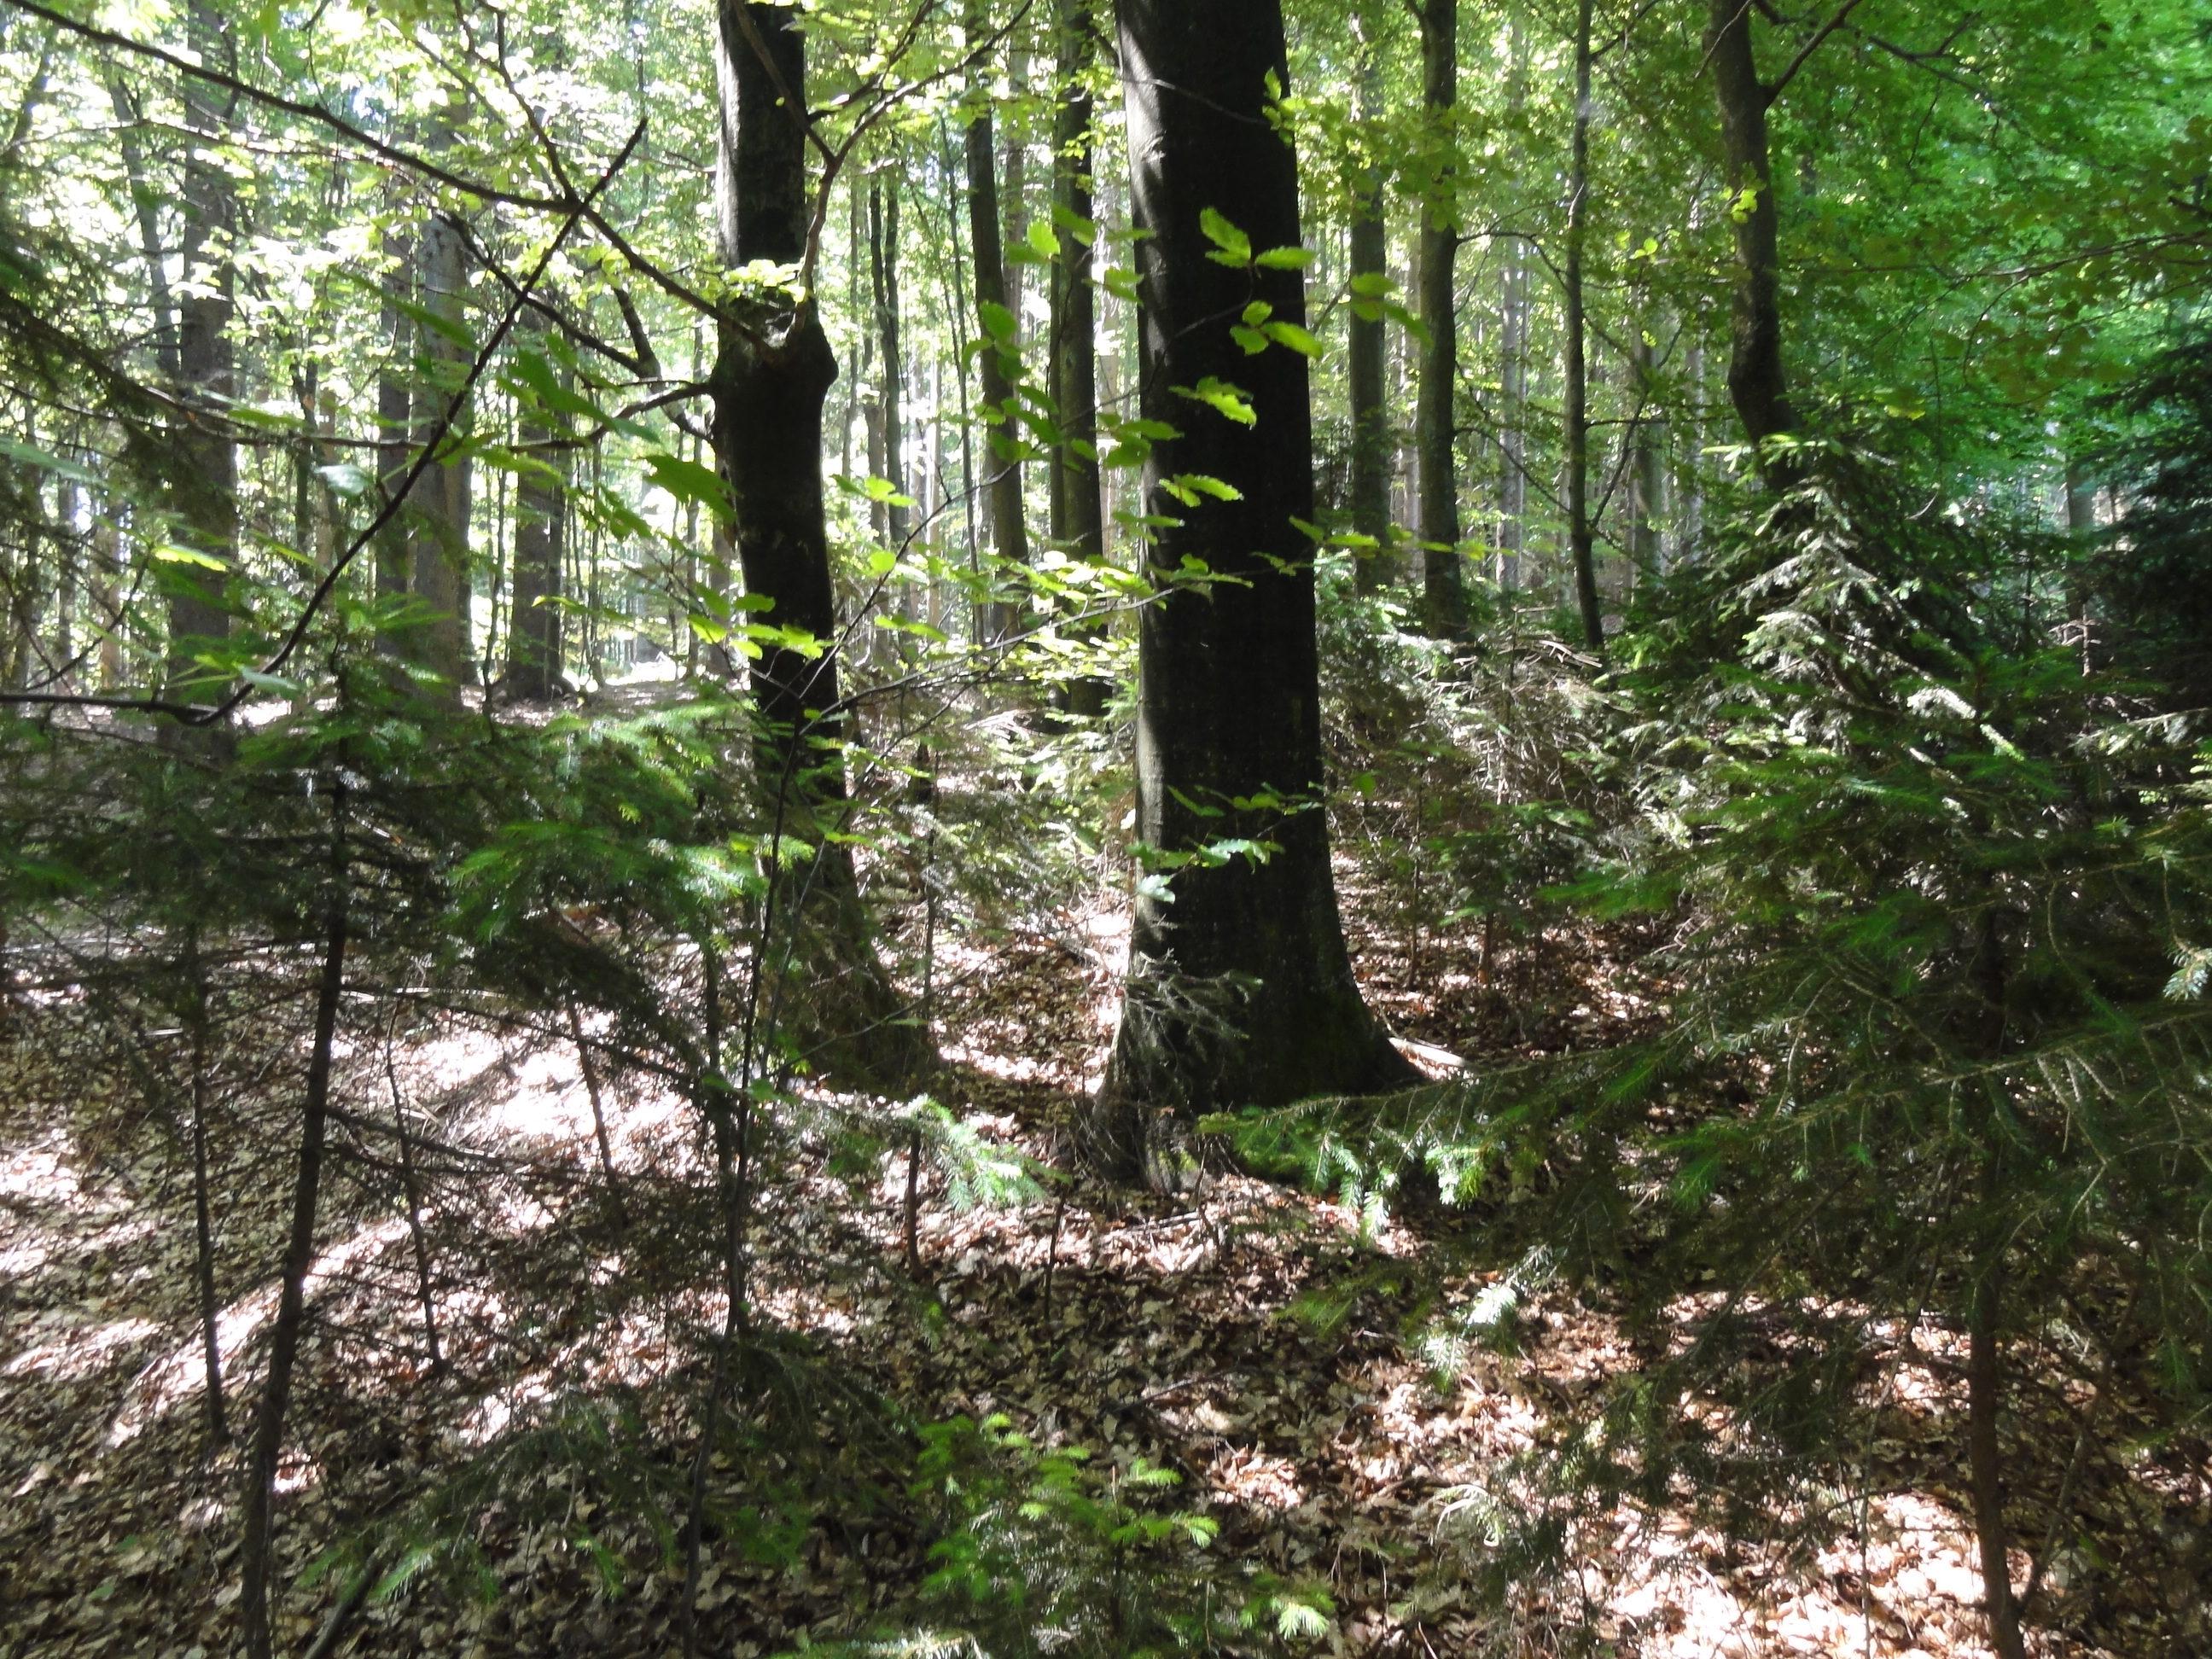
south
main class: Woodland
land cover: Spruce dominated mixed woodland
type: mountainous beech forest
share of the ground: 50 - 75 %
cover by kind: broadleaved forest trees 35 %, coniferous forest trees 30 %, shrubs 20 %, herbaceous plants 5 %, unconsolidated bare surface 5 %
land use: Forestry
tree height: > 5 m
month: June
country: SI
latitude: 46.2071
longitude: 14.8055
